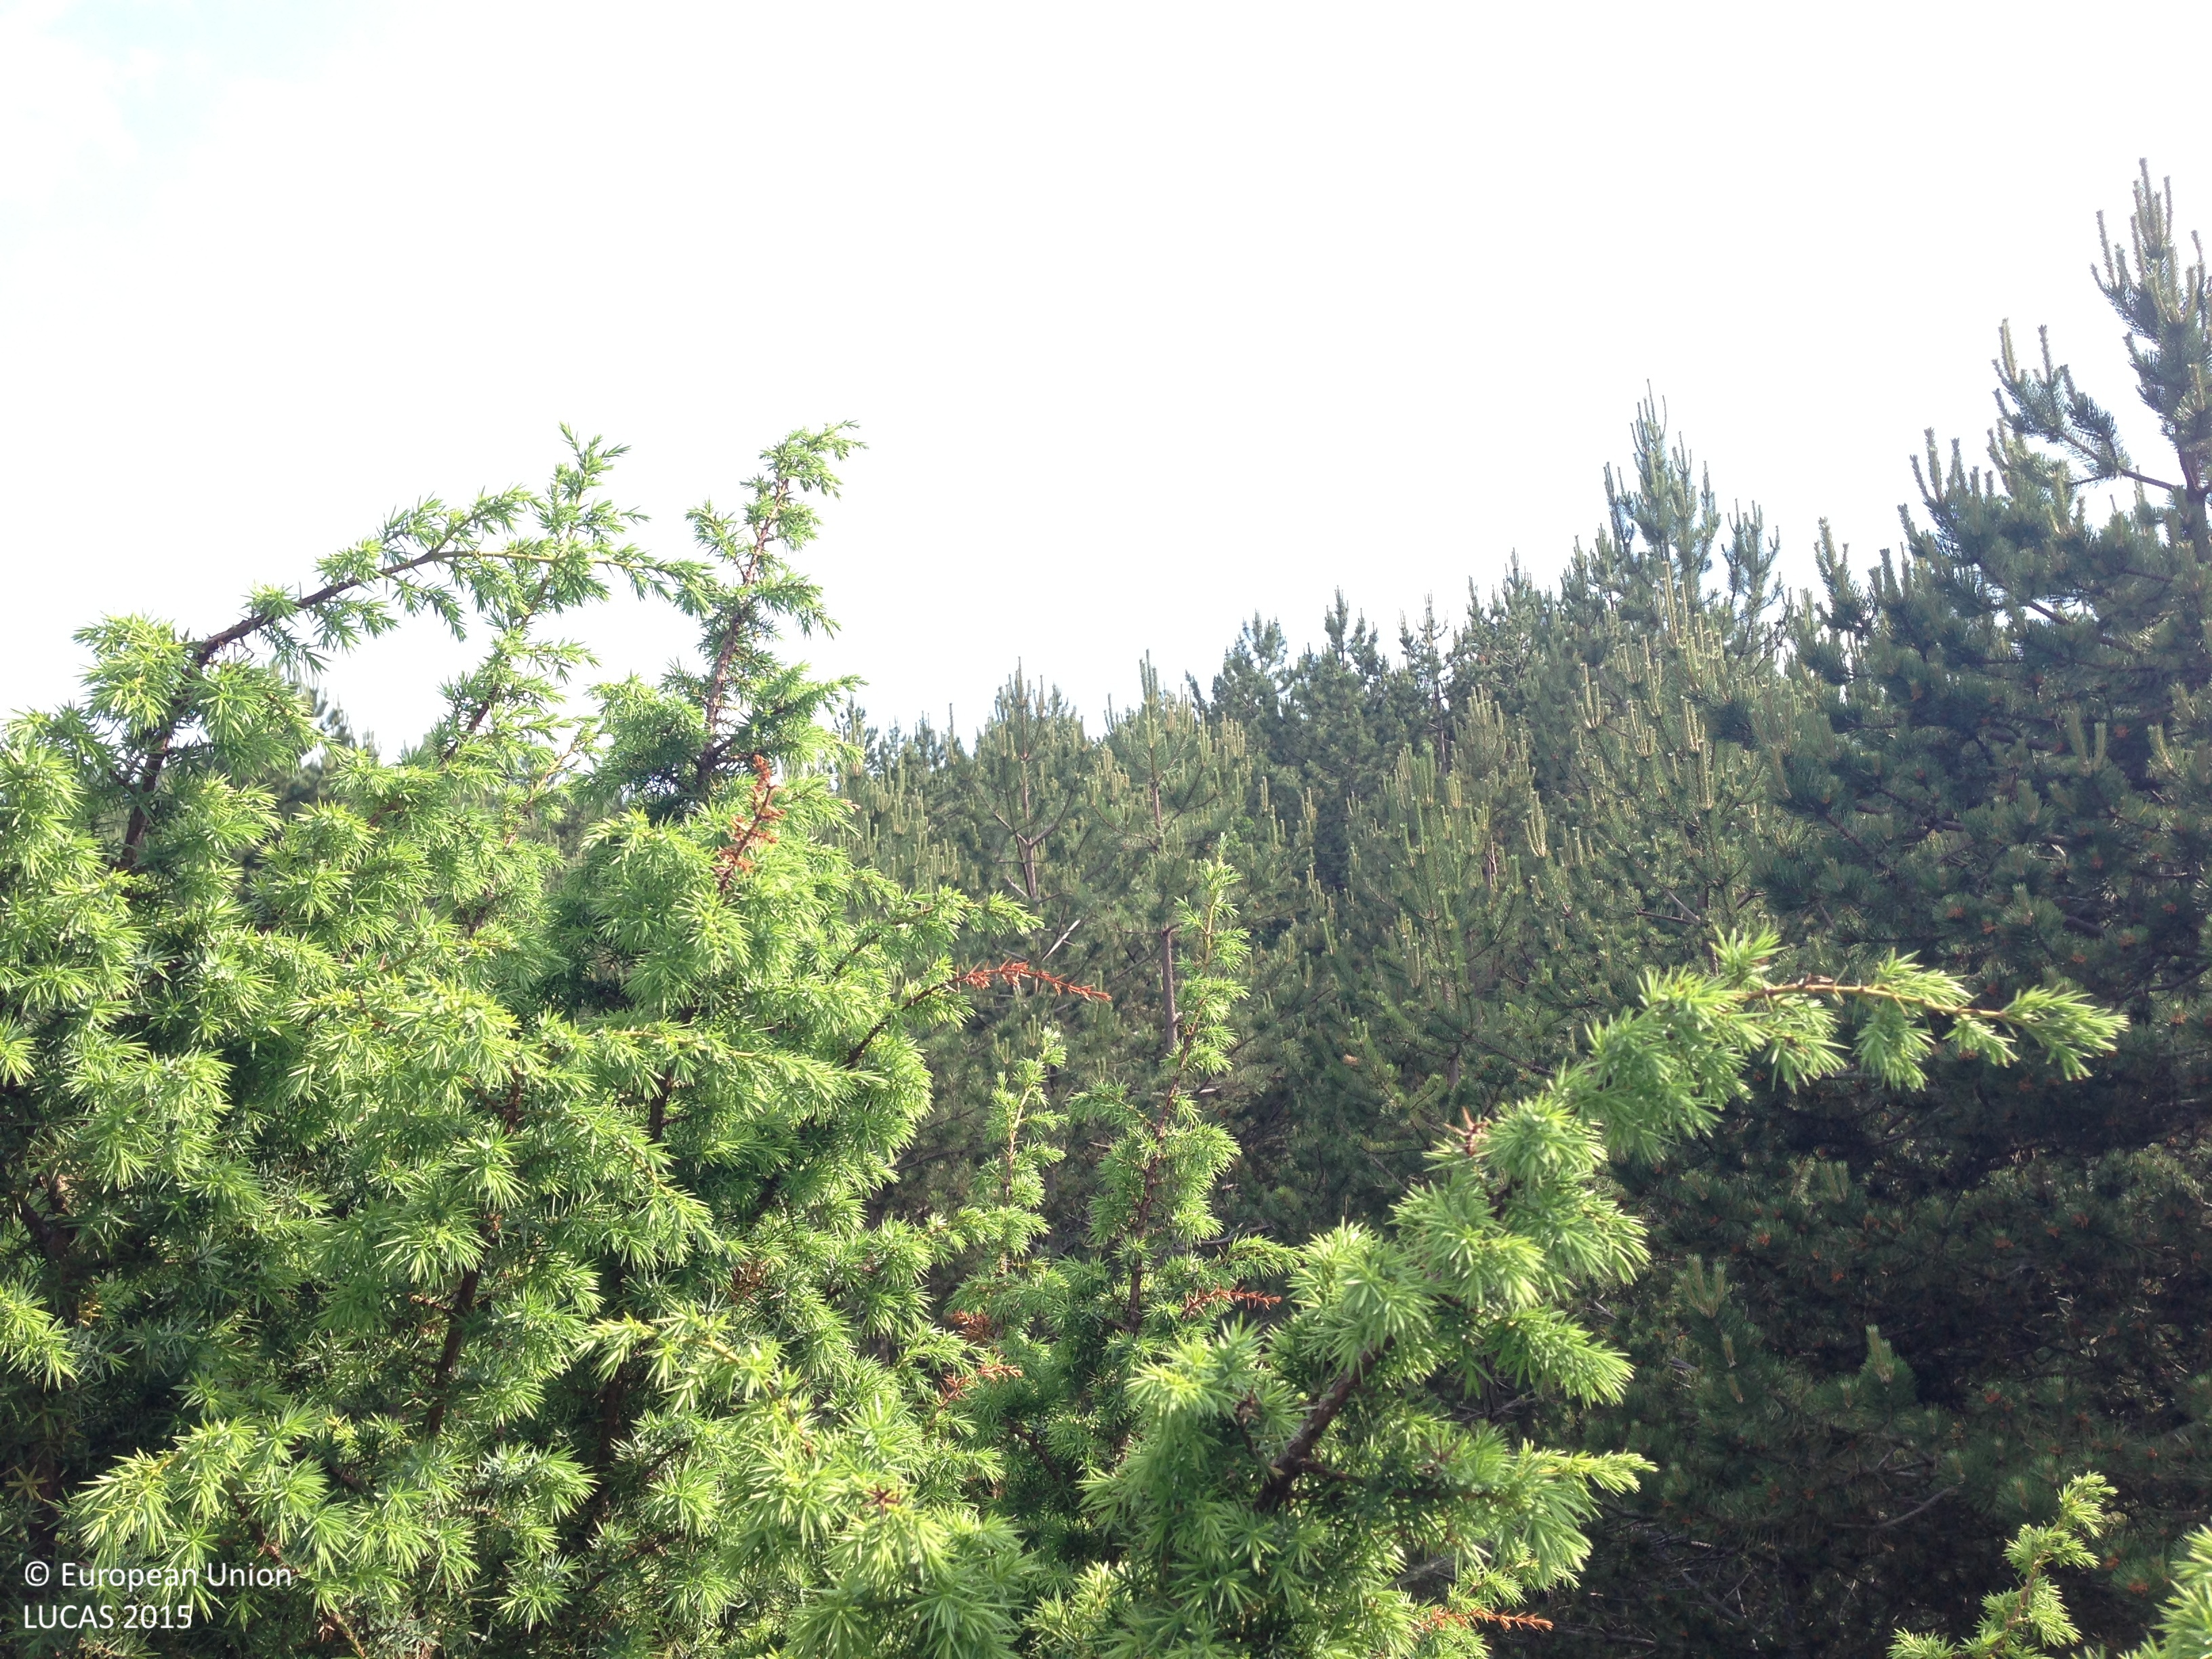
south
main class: Woodland
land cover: Pine dominated coniferous woodland
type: coniferous forest of the mediterranean region
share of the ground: 50 - 75 %
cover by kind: coniferous forest trees 50 %, shrubs 30 %, broadleaved forest trees 5 %, herbaceous plants 5 %, consolidated bare surface 5 %, unconsolidated bare surface 5 %
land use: Semi-natural and natural areas not in use
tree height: > 5 m
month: June
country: HR
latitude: 43.7300
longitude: 16.5095
